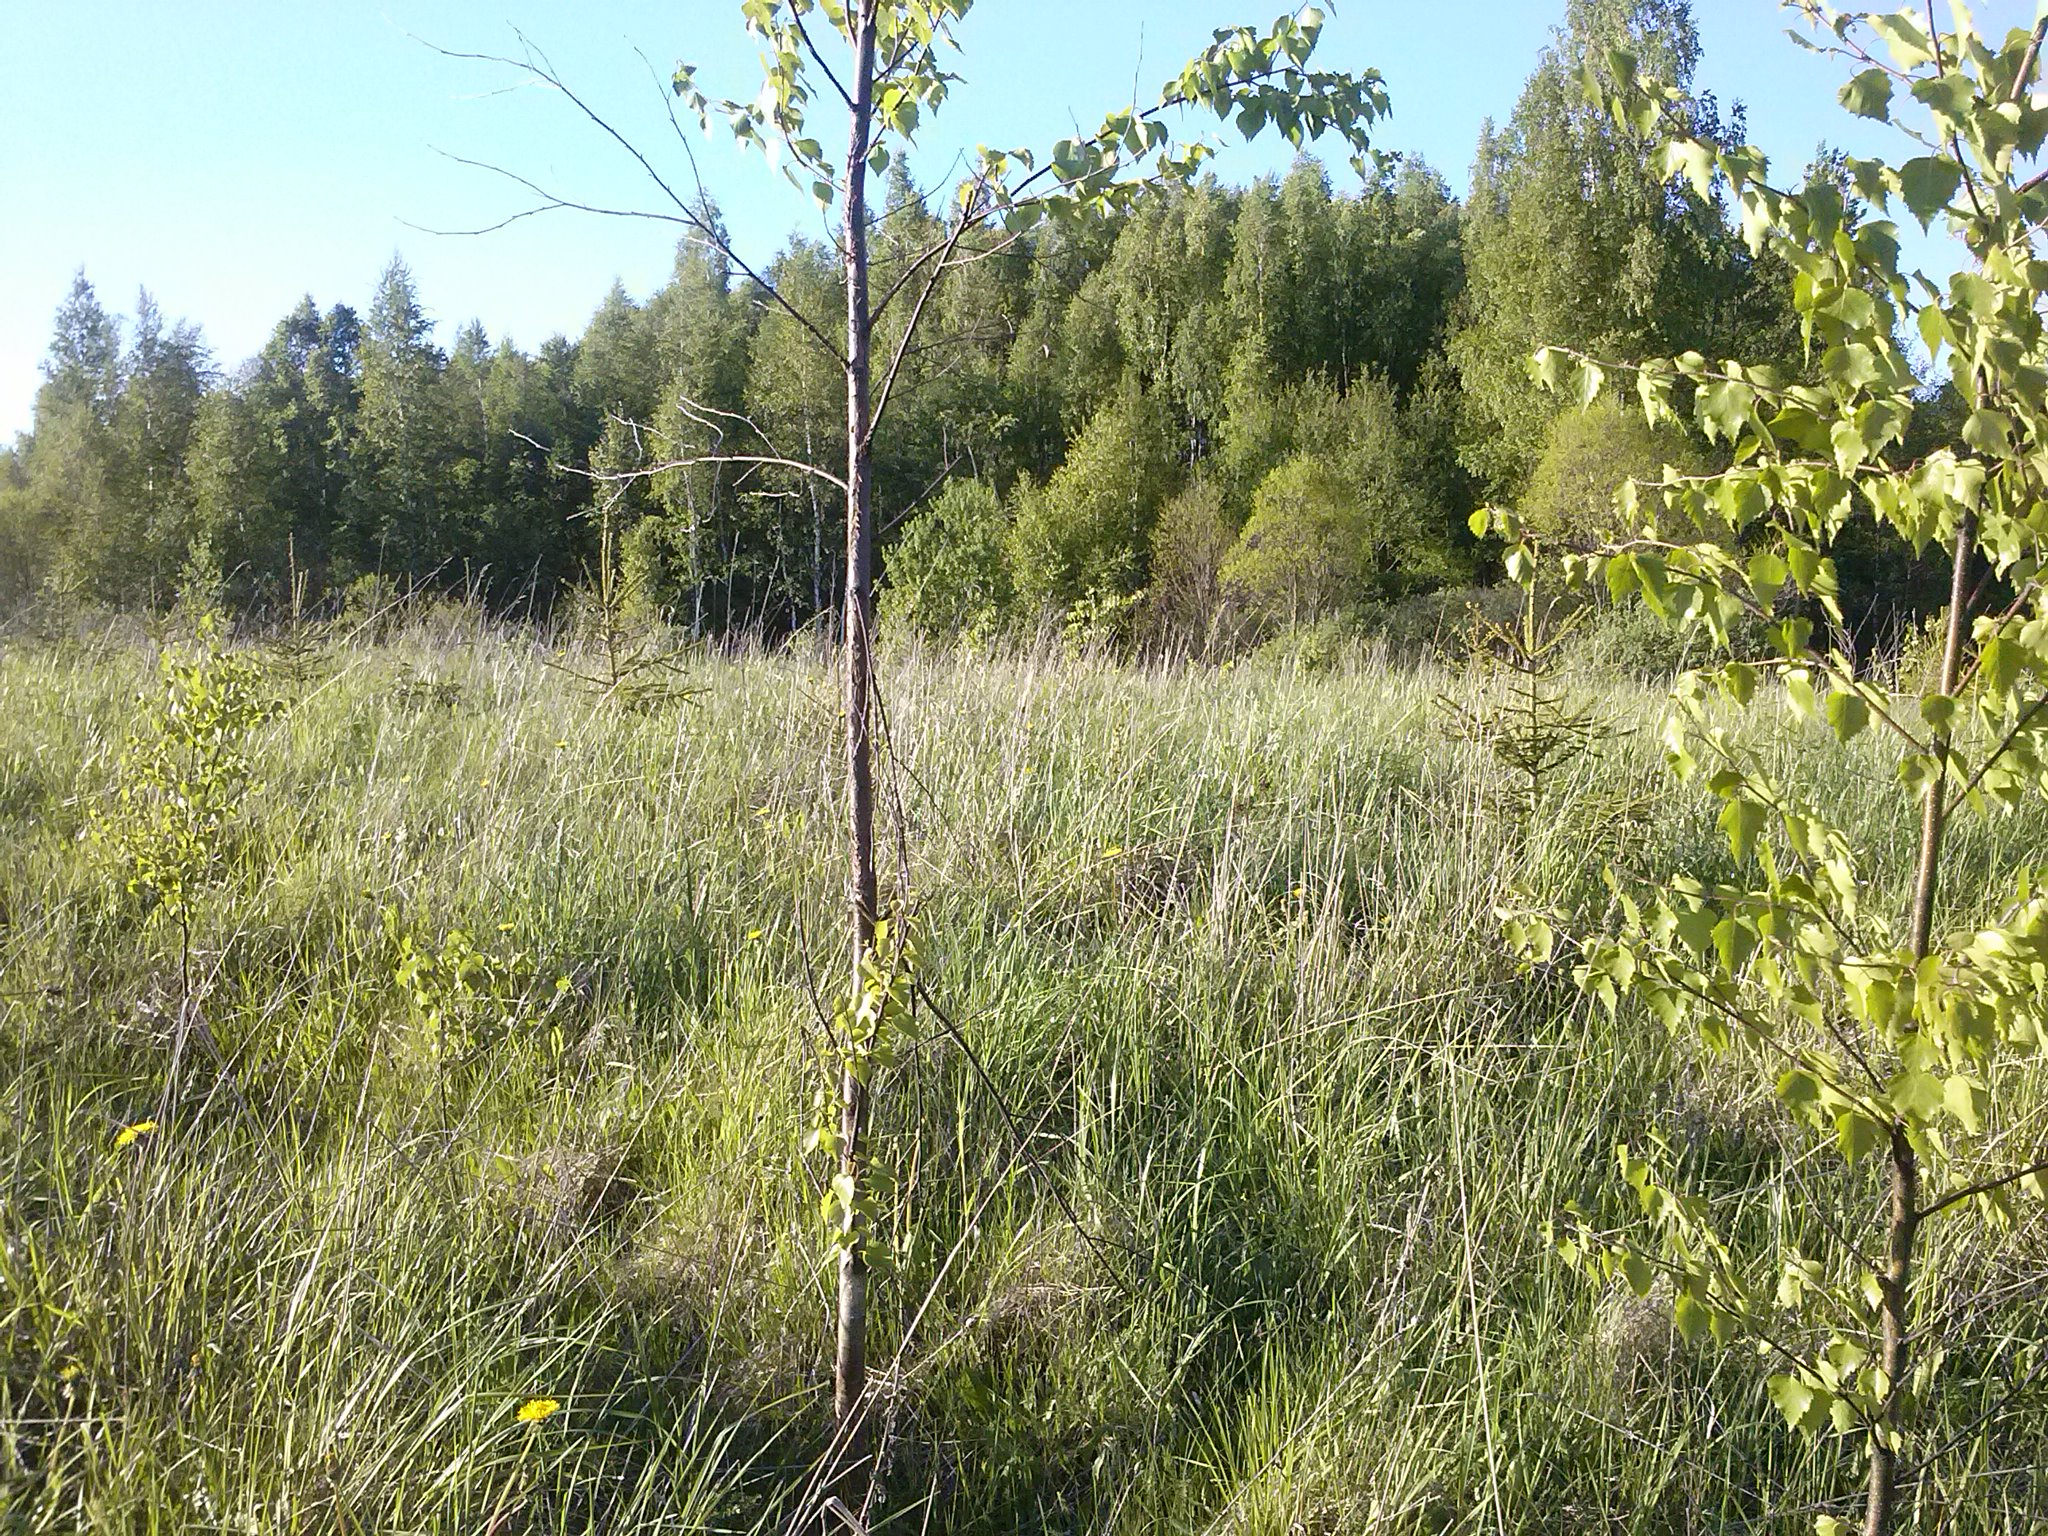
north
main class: Grassland
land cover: Grassland with sparse tree/shrub cover
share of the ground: > 75 %
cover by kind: herbaceous plants 90 %, coniferous forest trees 5 %, shrubs 5 %
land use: Forestry
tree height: < 5 m
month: May
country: LV
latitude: 56.1920
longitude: 27.8714
